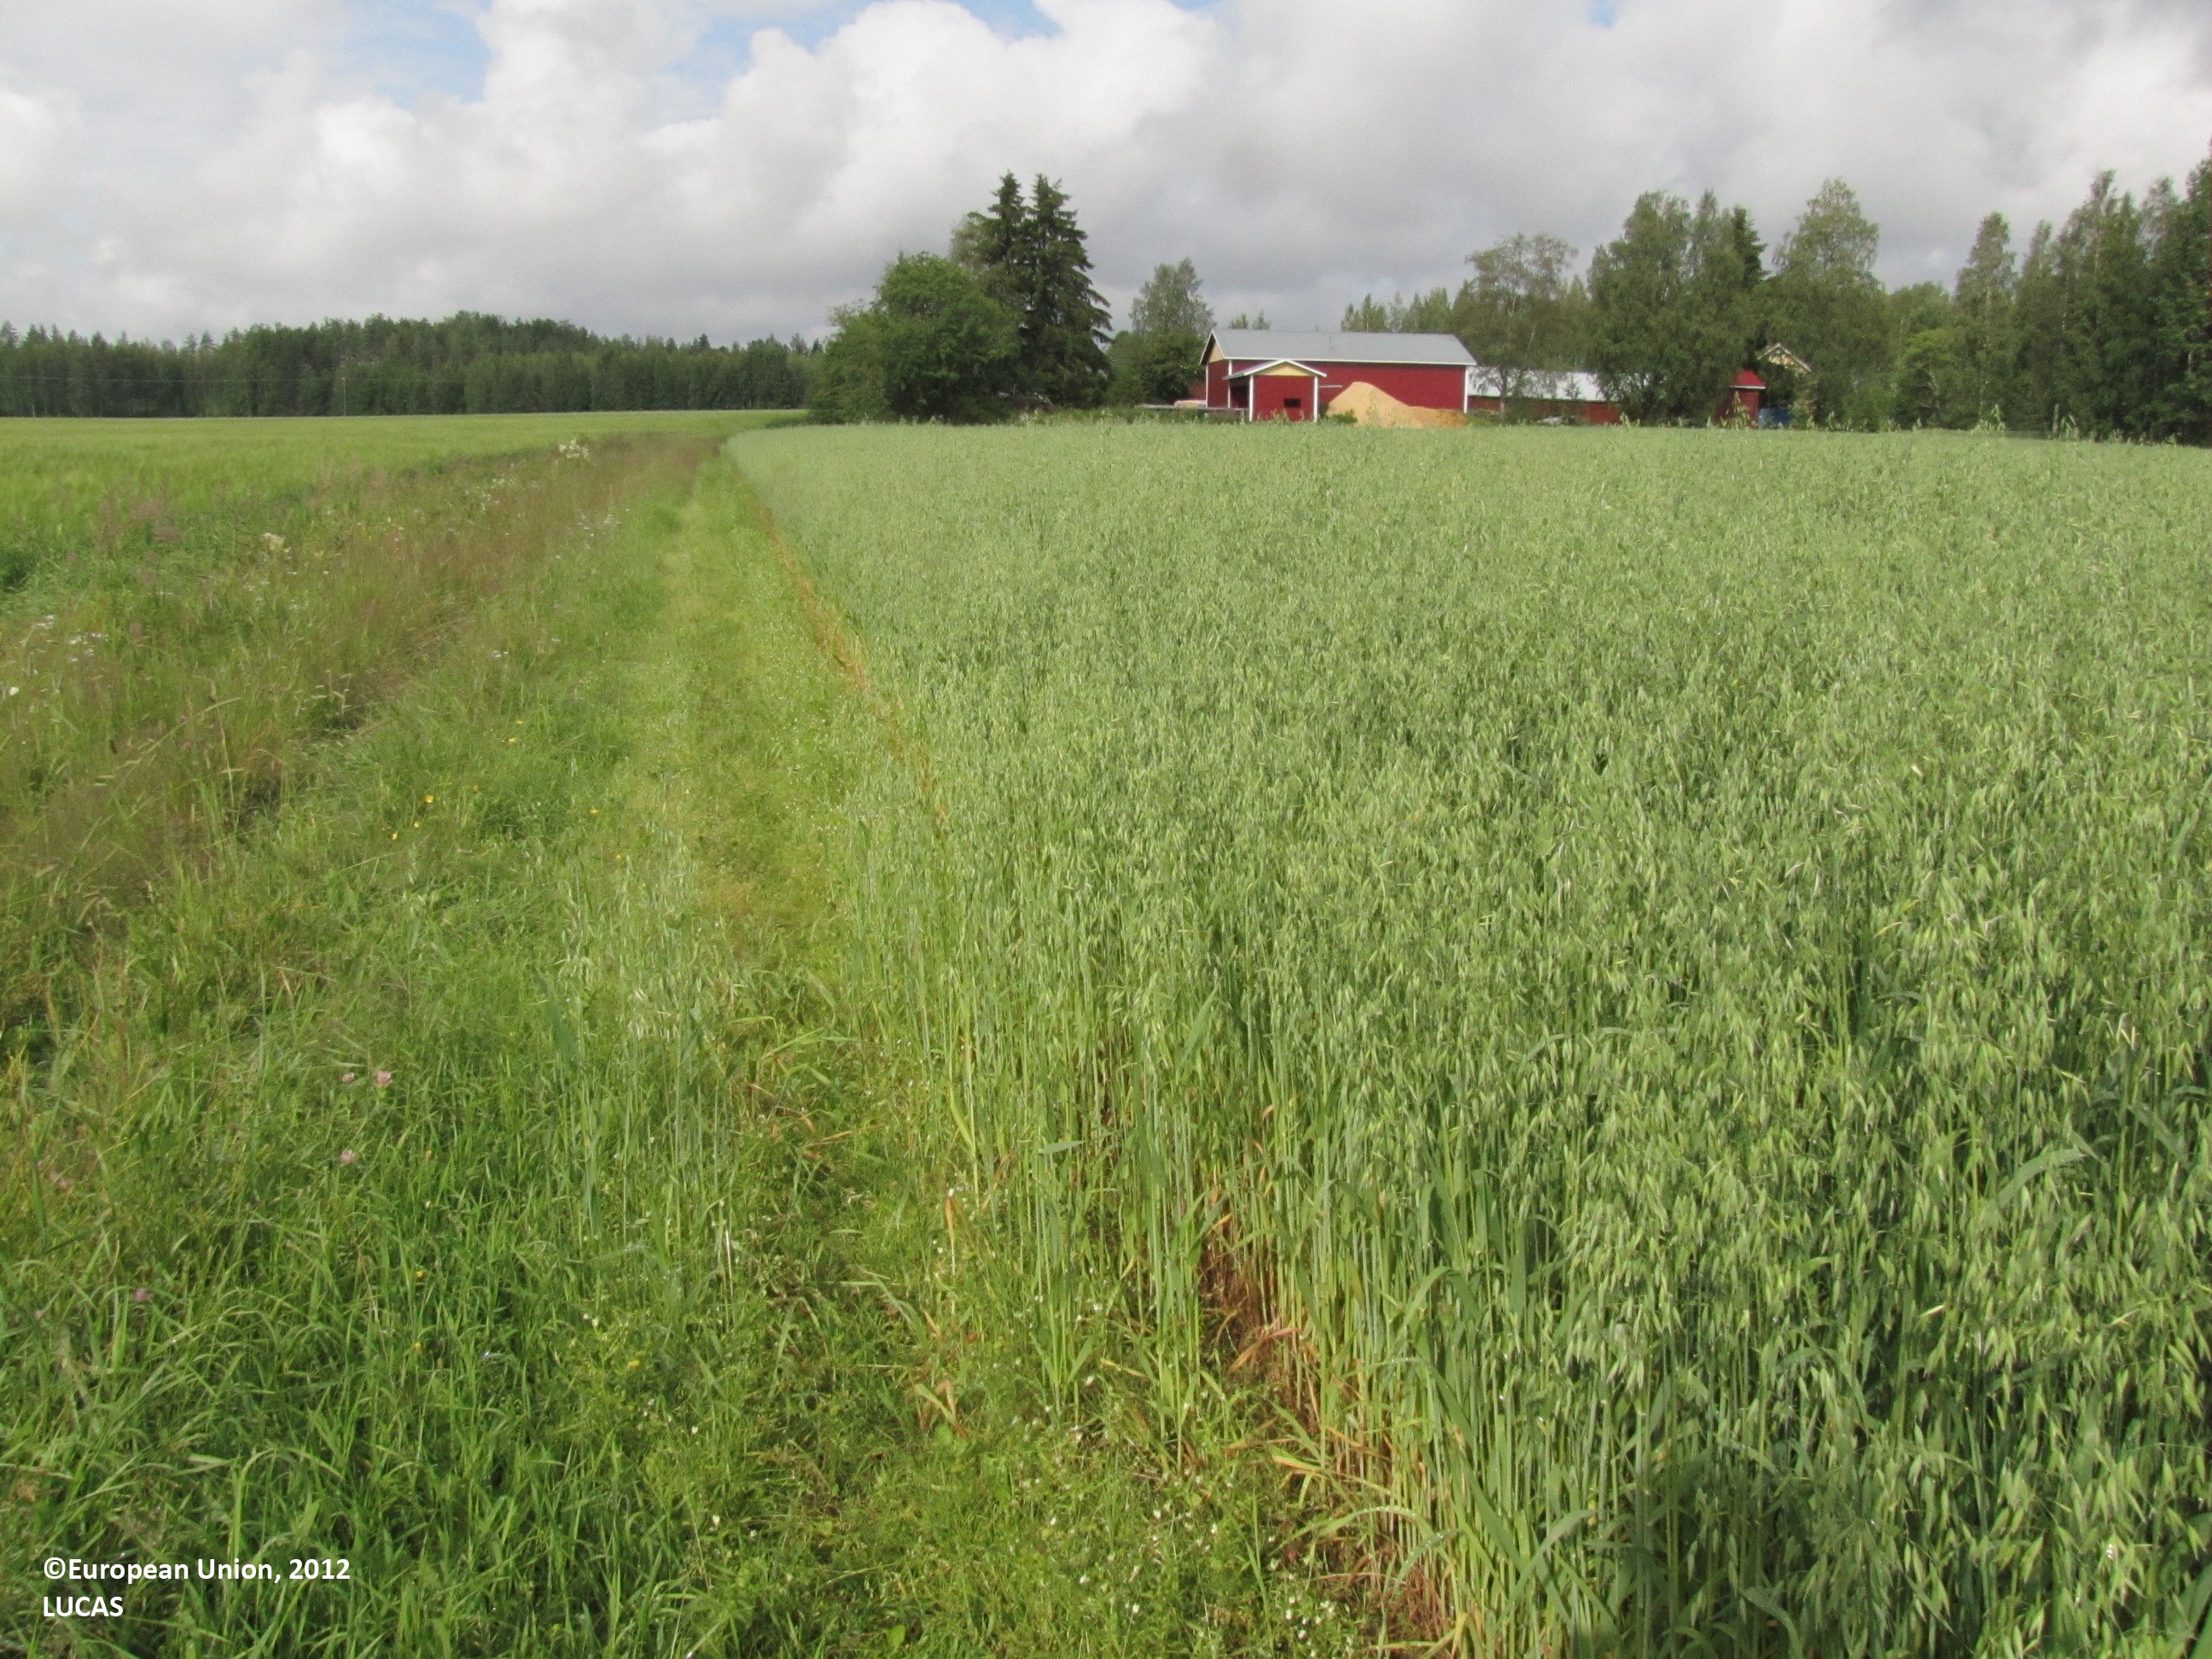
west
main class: Cropland
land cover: Oats
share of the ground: > 75 %
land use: Agriculture (excluding fallow land and kitchen gardens)
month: July
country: FI
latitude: 62.1650
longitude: 23.1026
